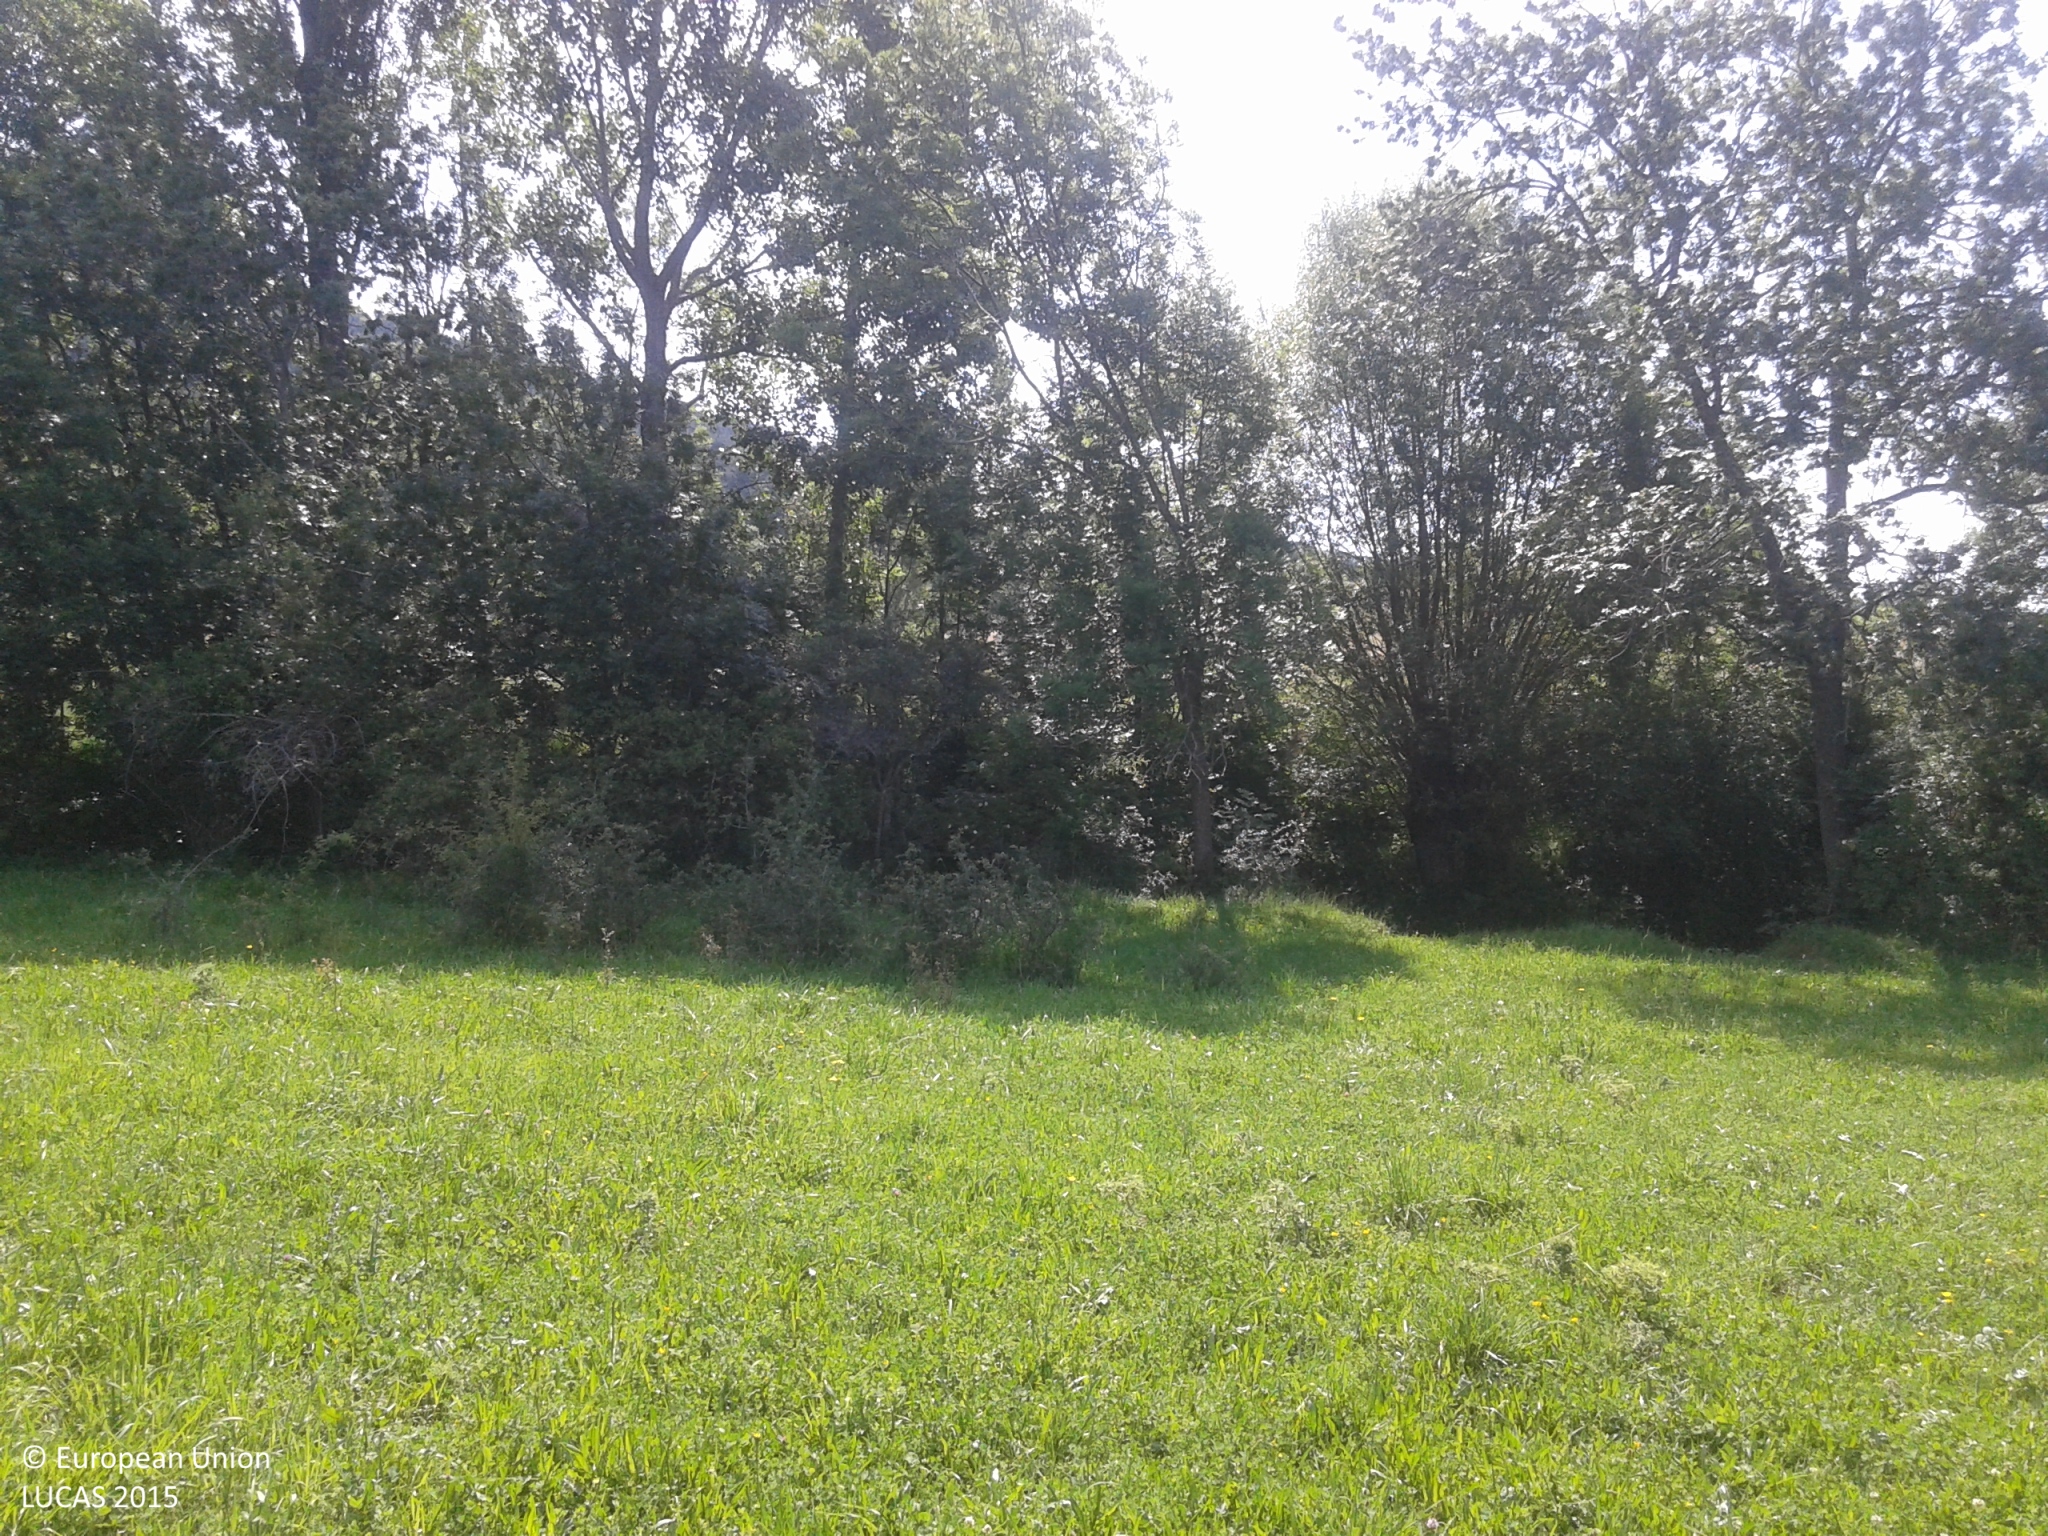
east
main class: Grassland
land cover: Grassland with sparse tree/shrub cover
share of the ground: > 75 %
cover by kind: herbaceous plants 90 %, broadleaved forest trees 5 %, shrubs 5 %
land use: Agriculture (excluding fallow land and kitchen gardens)
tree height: < 5 m
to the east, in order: Grassland with sparse tree/shrub cover; Rivers and streams; Broadleaved woodland; Fences; Spontaneously vegetated surfaces; Dry stone walls; Spontaneously vegetated surfaces; Dry stone walls; Spontaneously vegetated surfaces; Dry stone walls; Fences; Grassland with sparse tree/shrub cover; Tracks; Grassland with sparse tree/shrub cover
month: June
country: ES
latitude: 42.3926
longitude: 1.5675
